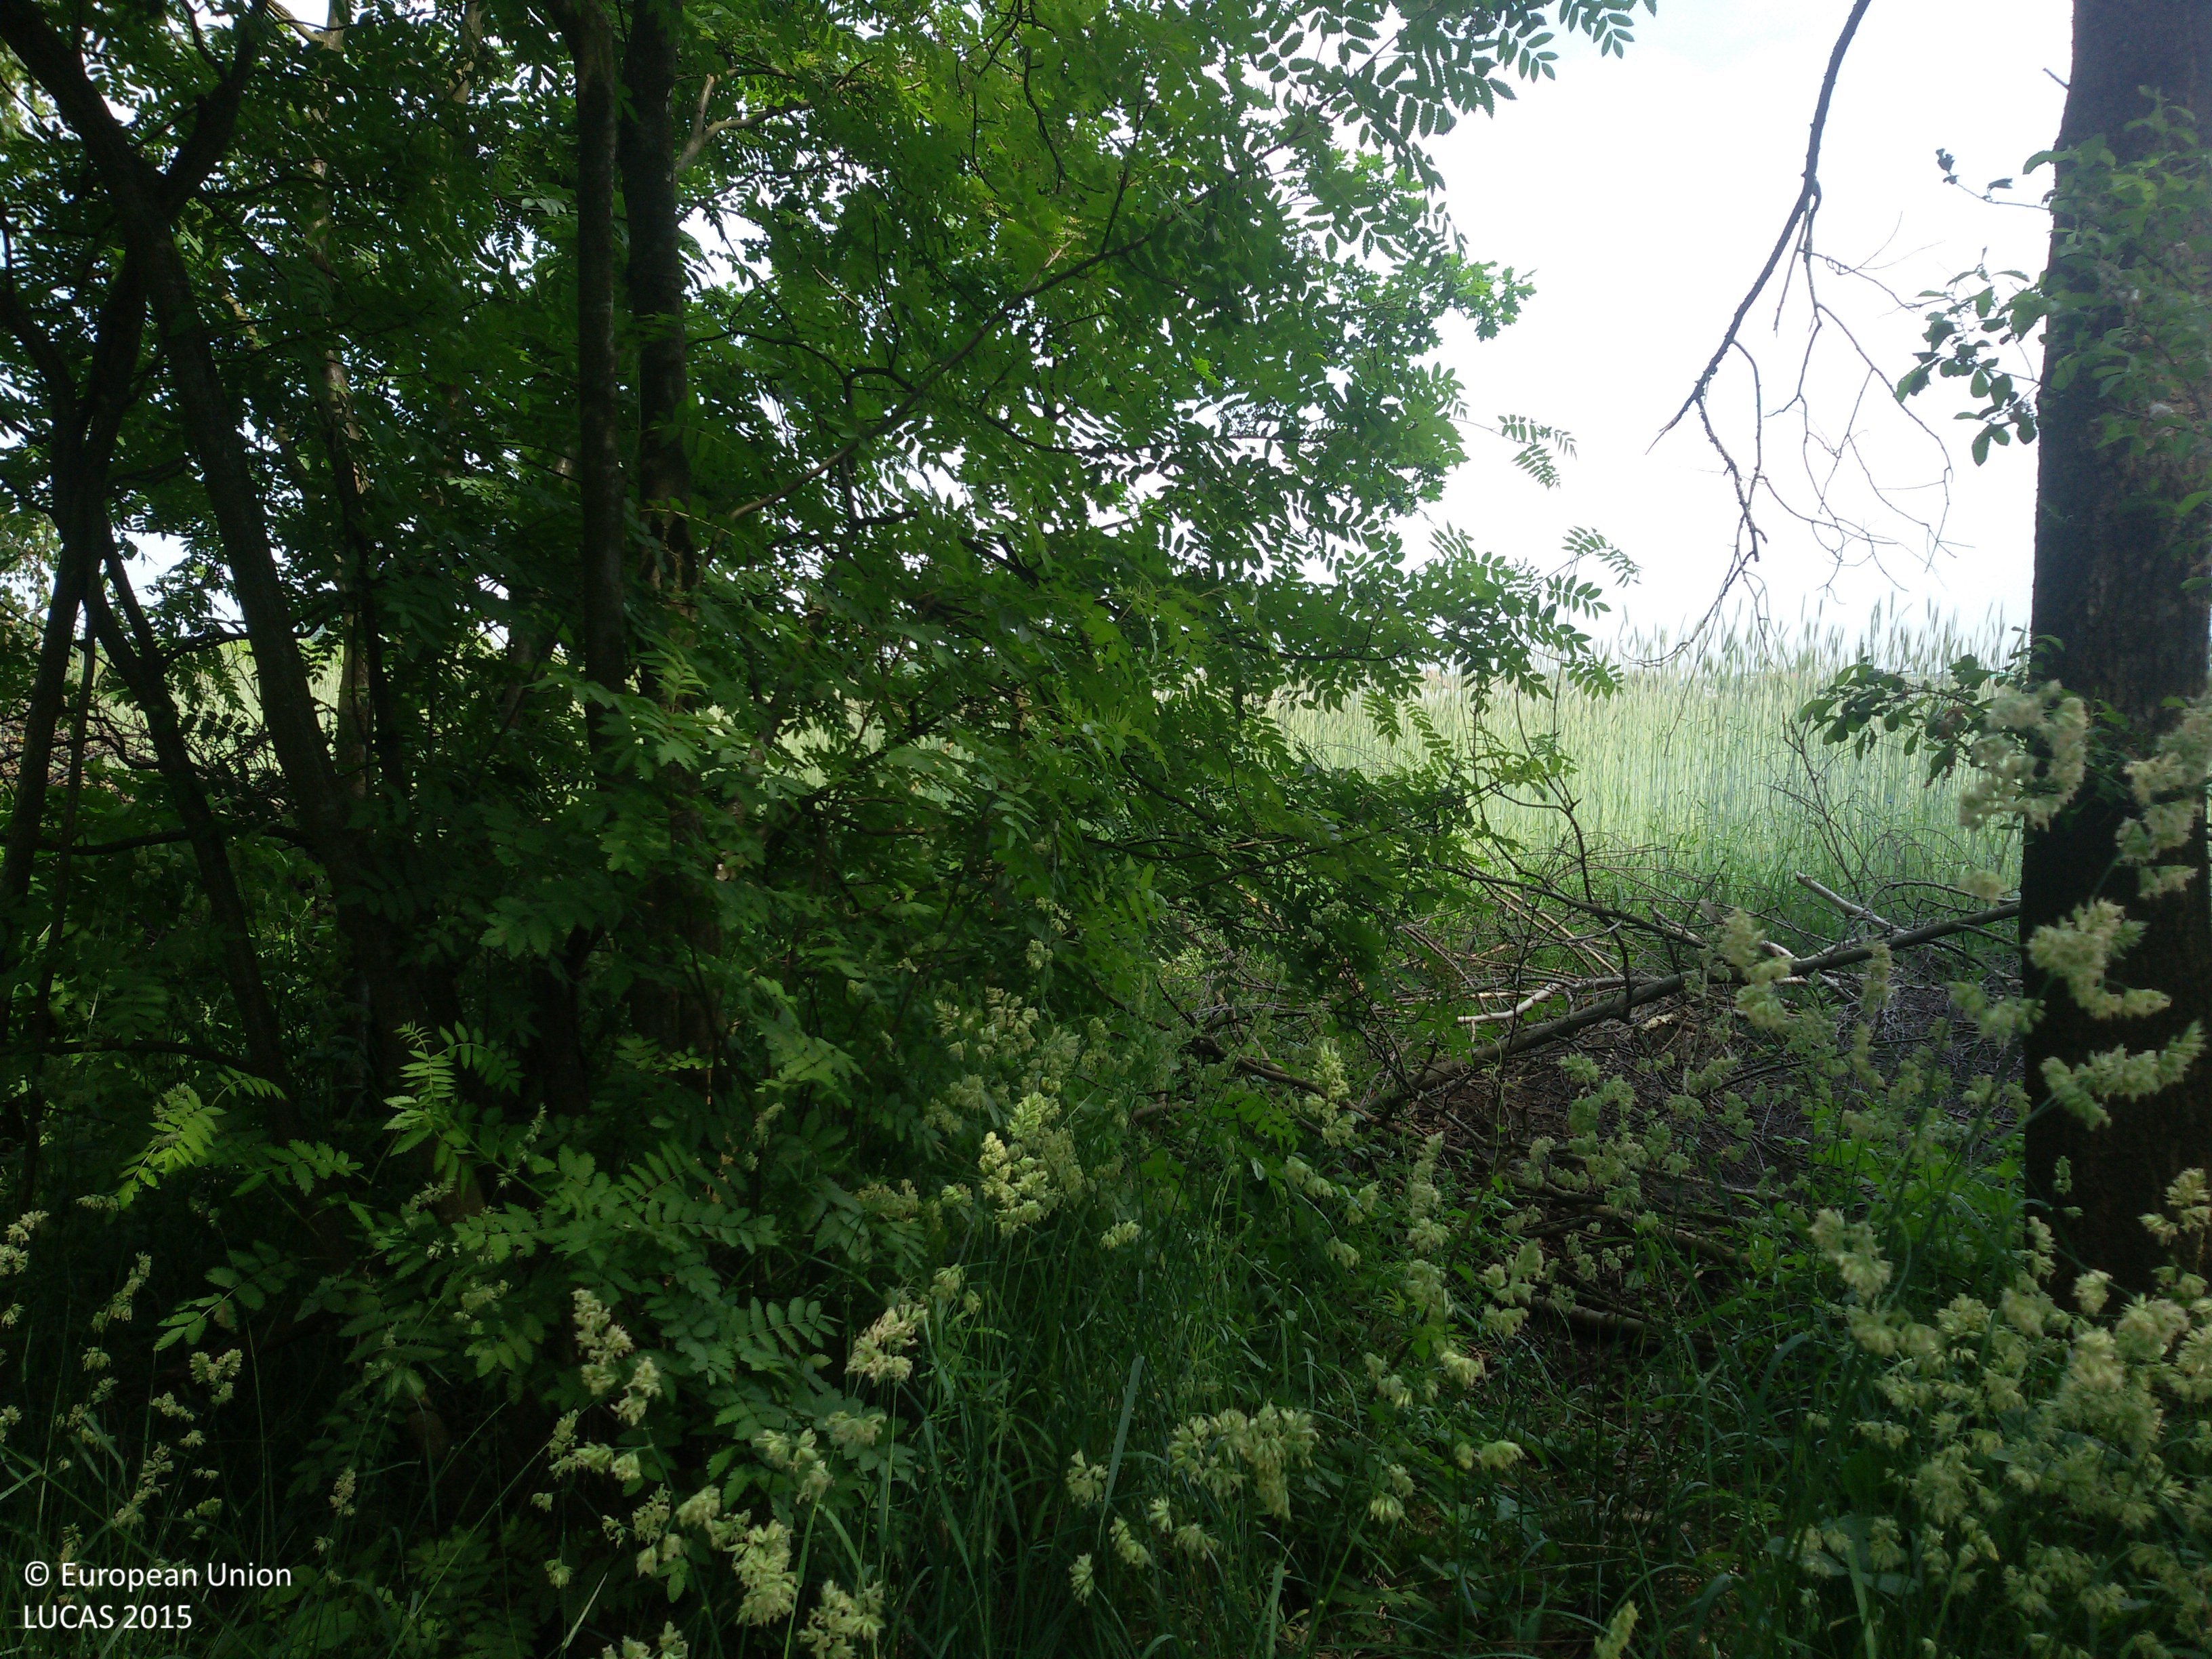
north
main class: Woodland
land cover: Broadleaved woodland
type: mesophytic deciduous forest
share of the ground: > 75 %
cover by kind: broadleaved forest trees 90 %, herbaceous plants 10 %
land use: Forestry
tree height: > 5 m
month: June
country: PL
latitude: 51.4973
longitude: 20.6564
